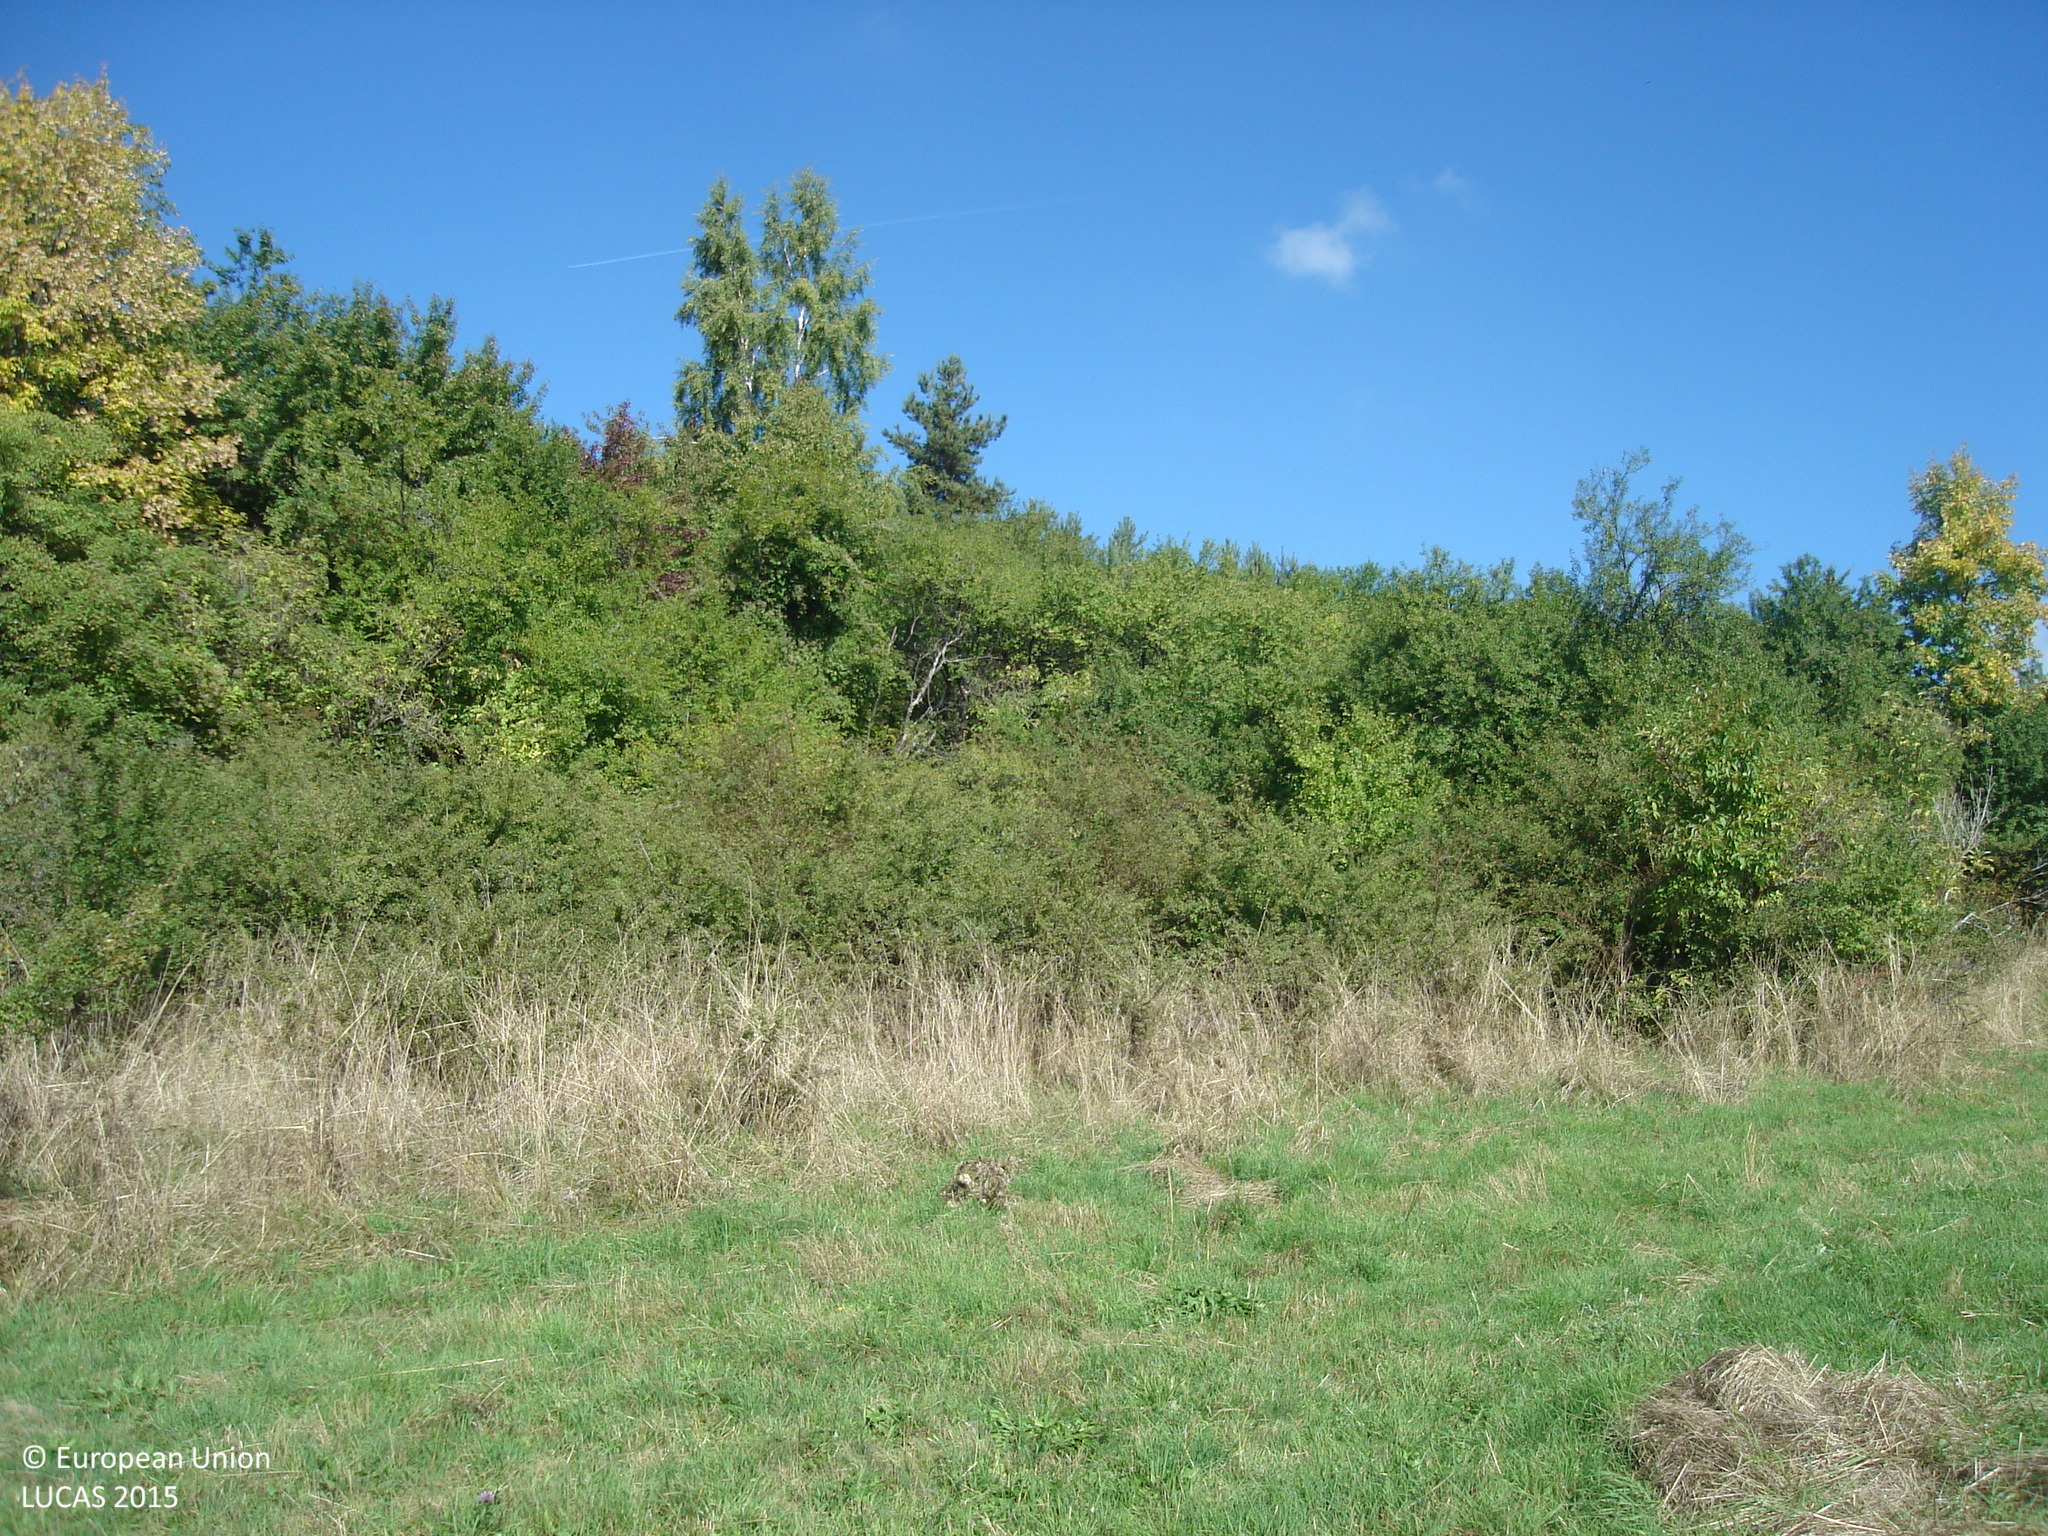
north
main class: Grassland
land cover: Grassland without tree/shrub cover
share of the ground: > 75 %
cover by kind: herbaceous plants 100 %
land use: Agriculture (excluding fallow land and kitchen gardens)
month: October
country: BG
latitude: 43.0727
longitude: 23.1393
